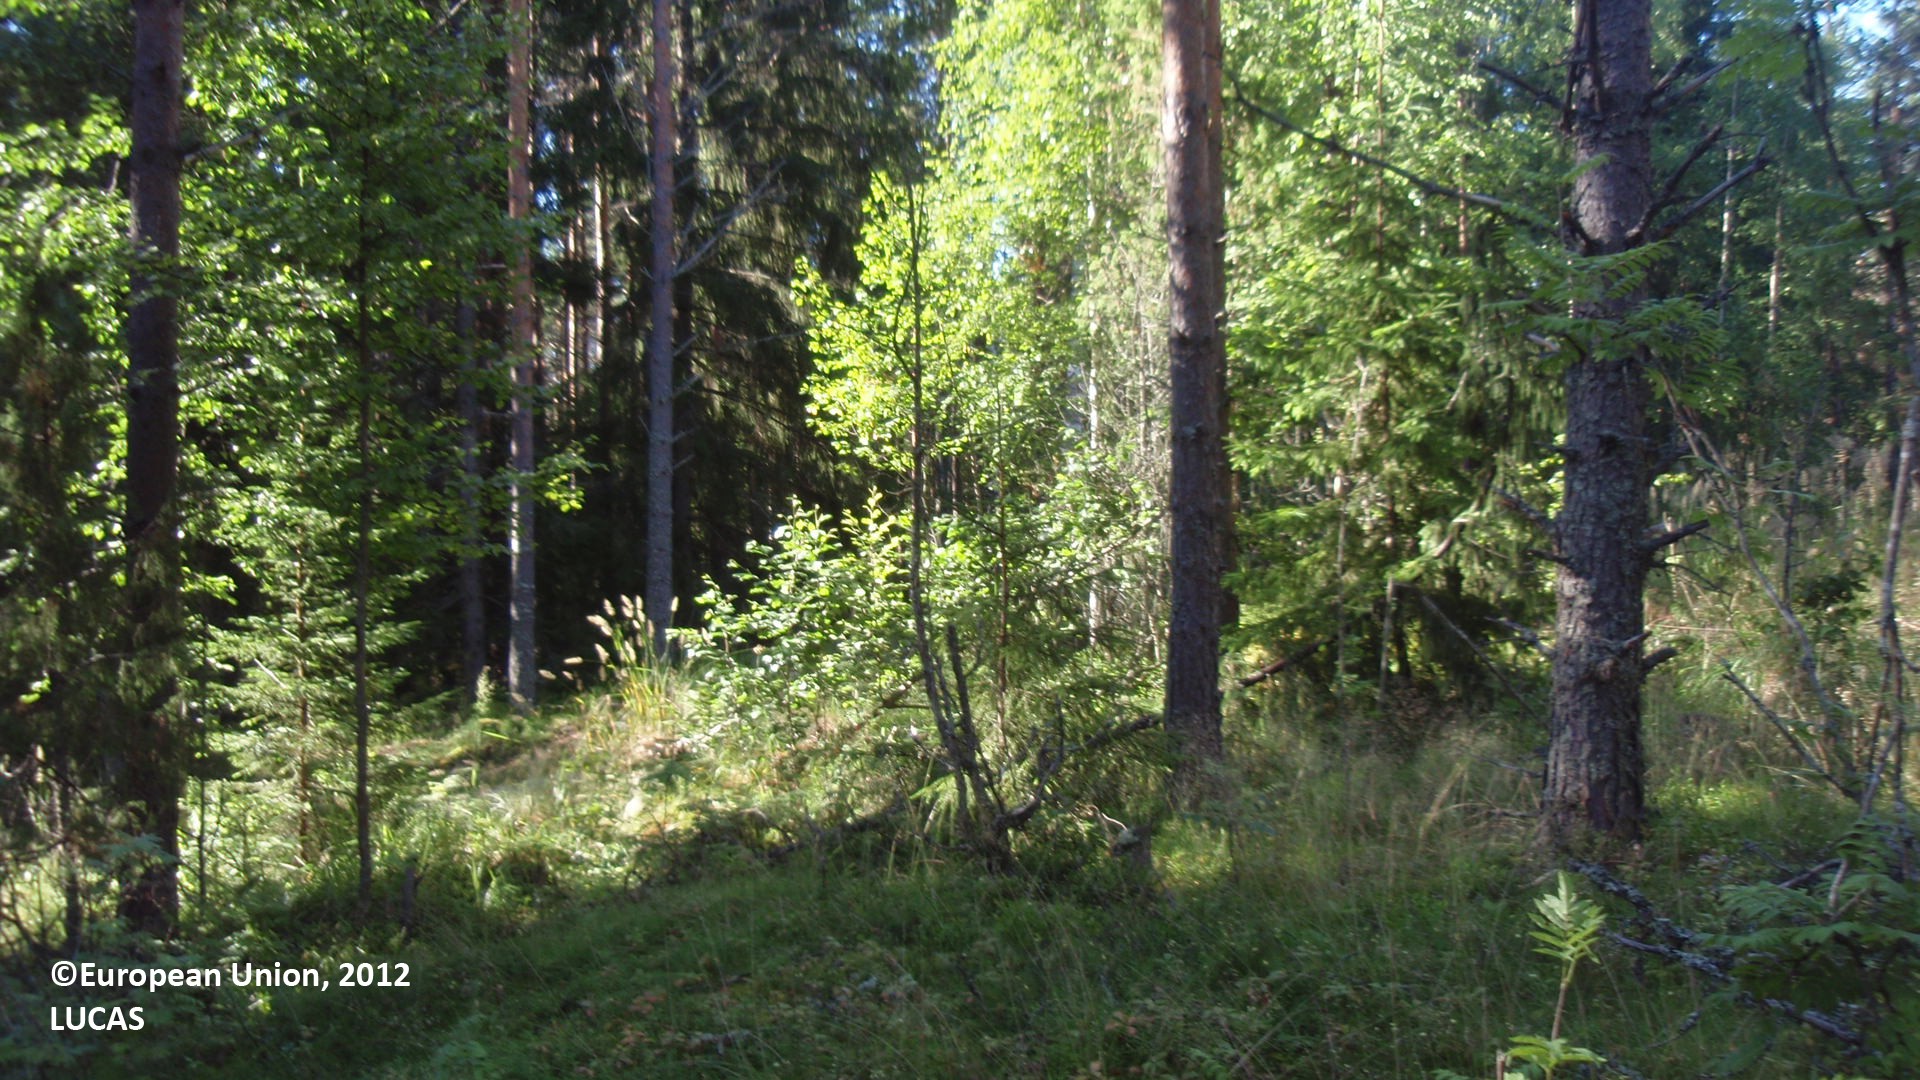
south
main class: Woodland
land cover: Pine dominated coniferous woodland
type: boreal forest
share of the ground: 50 - 75 %
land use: Forestry
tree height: > 5 m
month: July
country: FI
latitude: 61.5770
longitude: 28.2247
